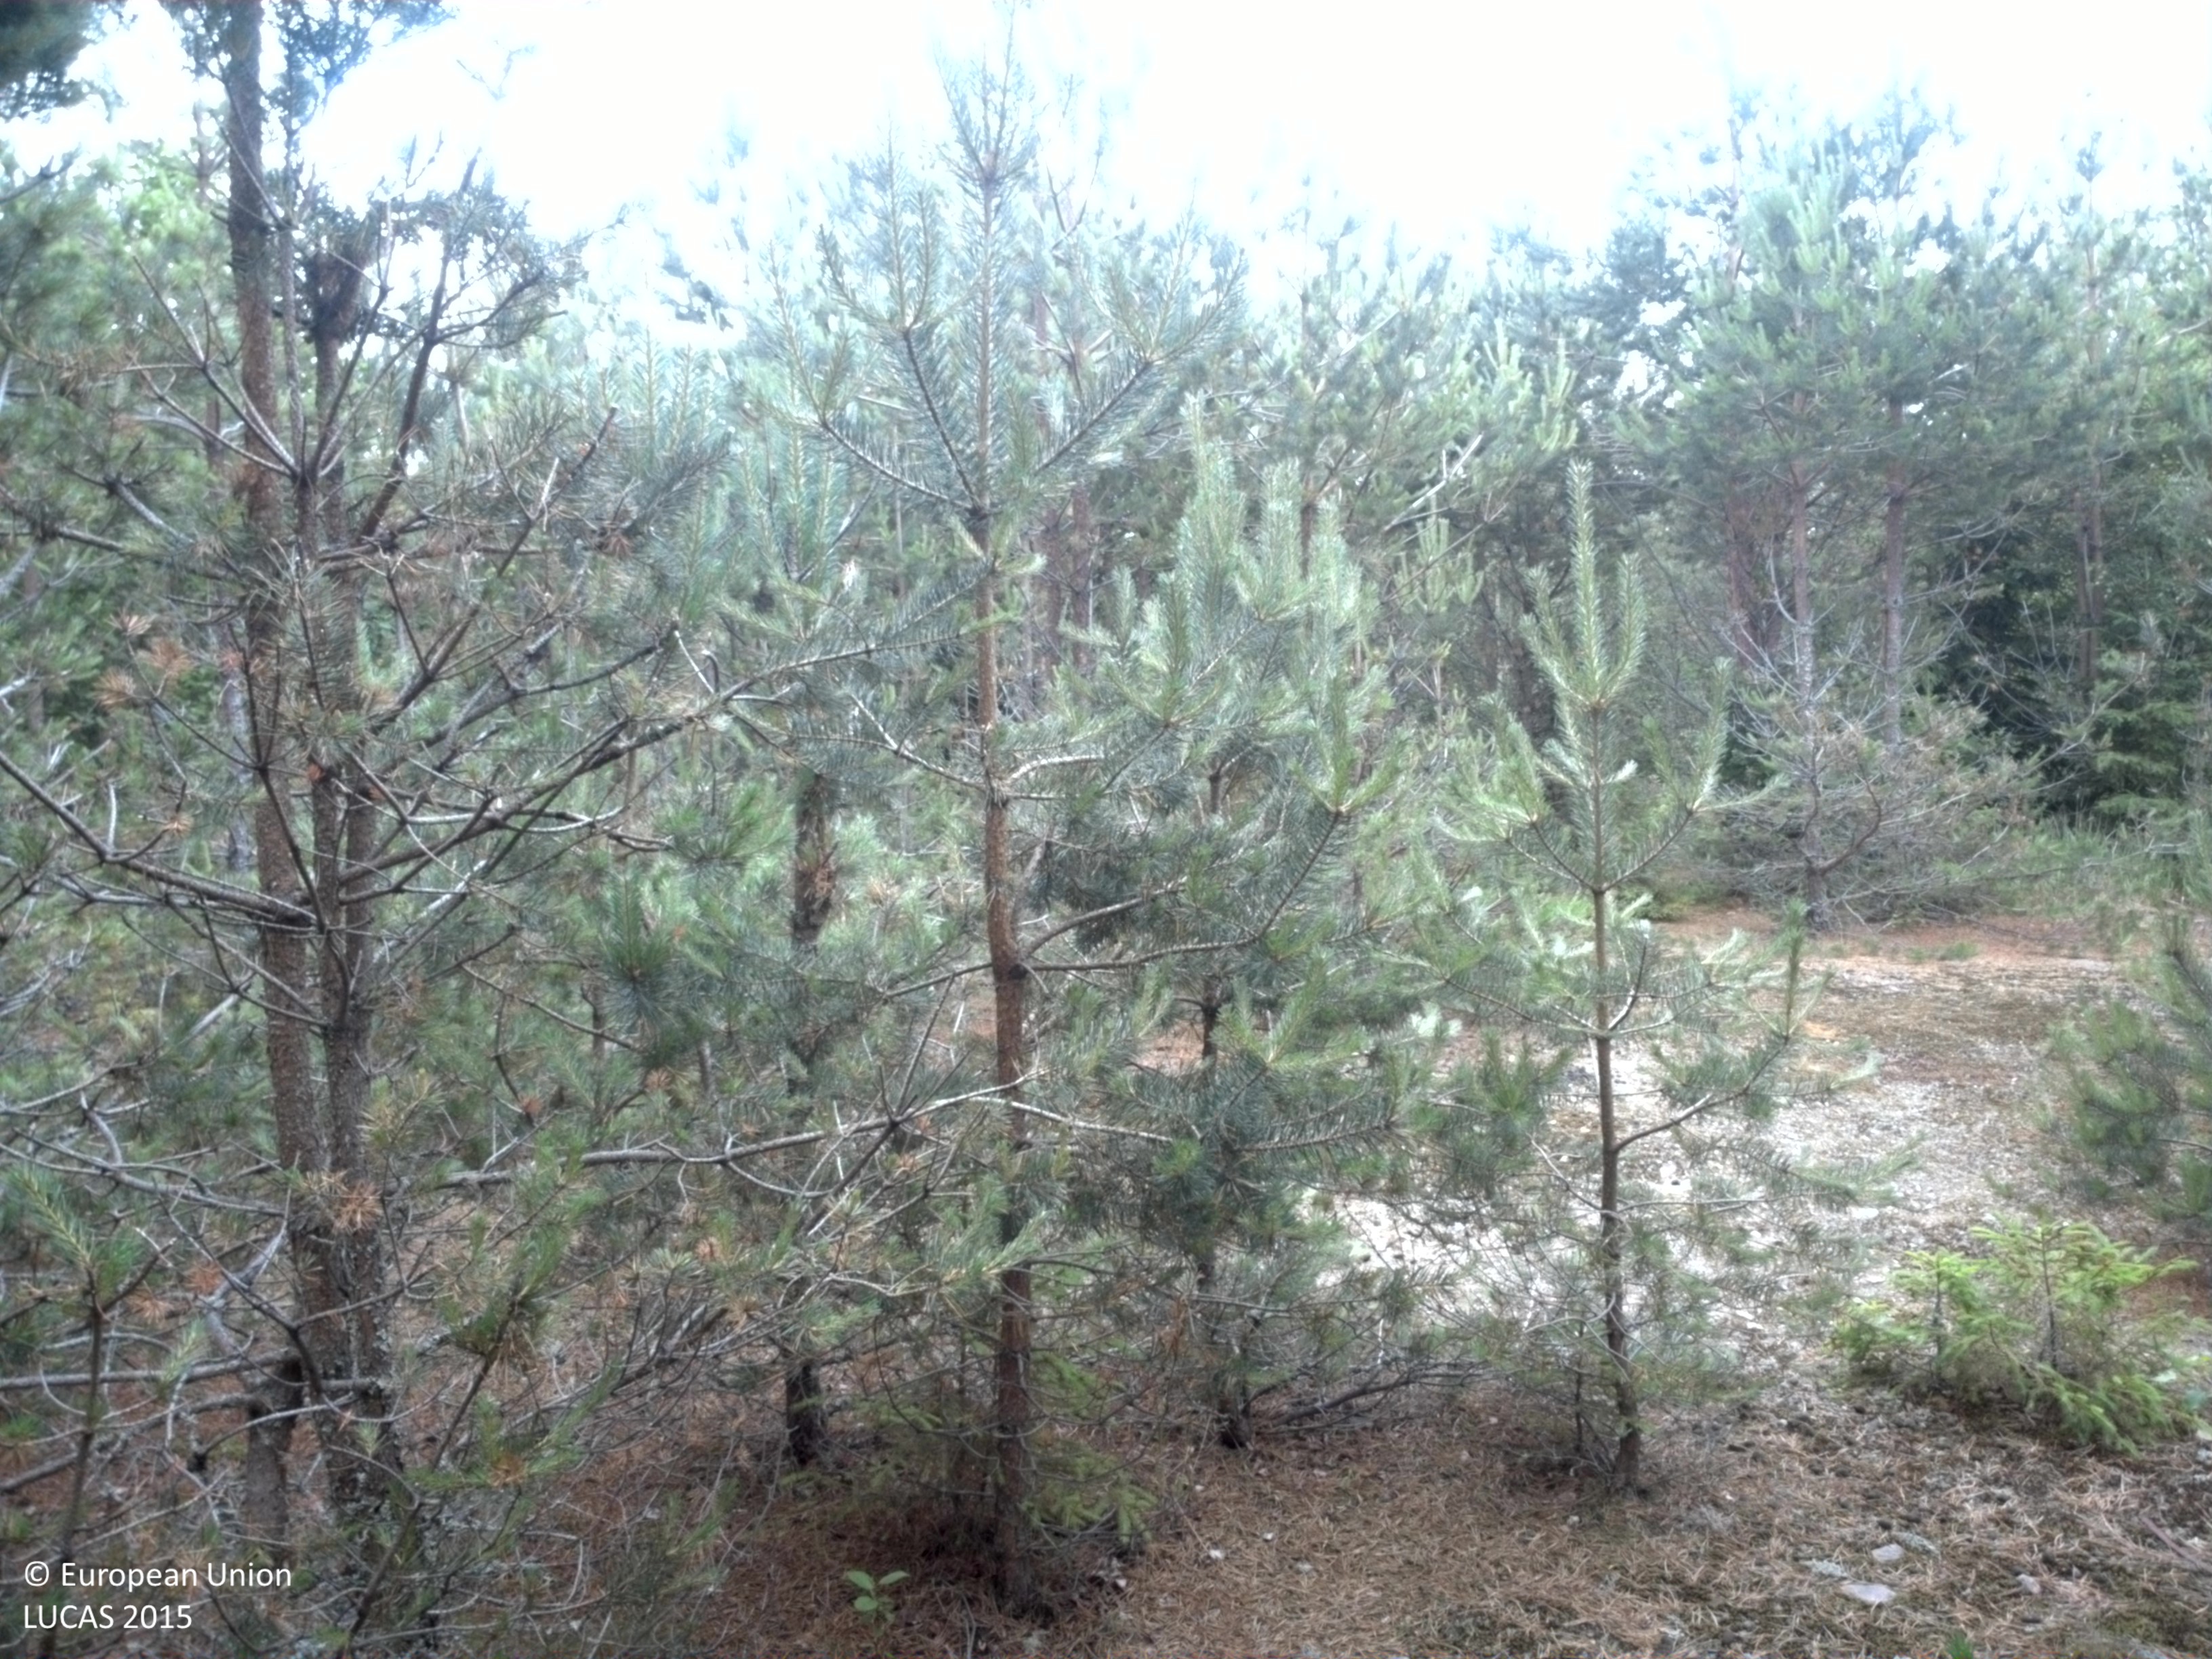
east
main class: Woodland
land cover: Pine dominated coniferous woodland
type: boreal forest
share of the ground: 10 - 25 %
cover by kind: consolidated bare surface 65 %, coniferous forest trees 20 %, broadleaved forest trees 5 %, shrubs 5 %, lichens and mosses 5 %
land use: Forestry
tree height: < 5 m
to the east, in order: Pine dominated coniferous woodland; Tracks; Pine dominated coniferous woodland; Tracks; Pine dominated coniferous woodland; Tracks; Pine dominated coniferous woodland; Pine dominated mixed woodland; Tracks; Pine dominated mixed woodland; Rivers and streams; Pine dominated mixed woodland; Shrubland with sparse tree cover; Rivers and streams; Shrubland with sparse tree cover
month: July
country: SE
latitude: 59.2959
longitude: 12.3996
